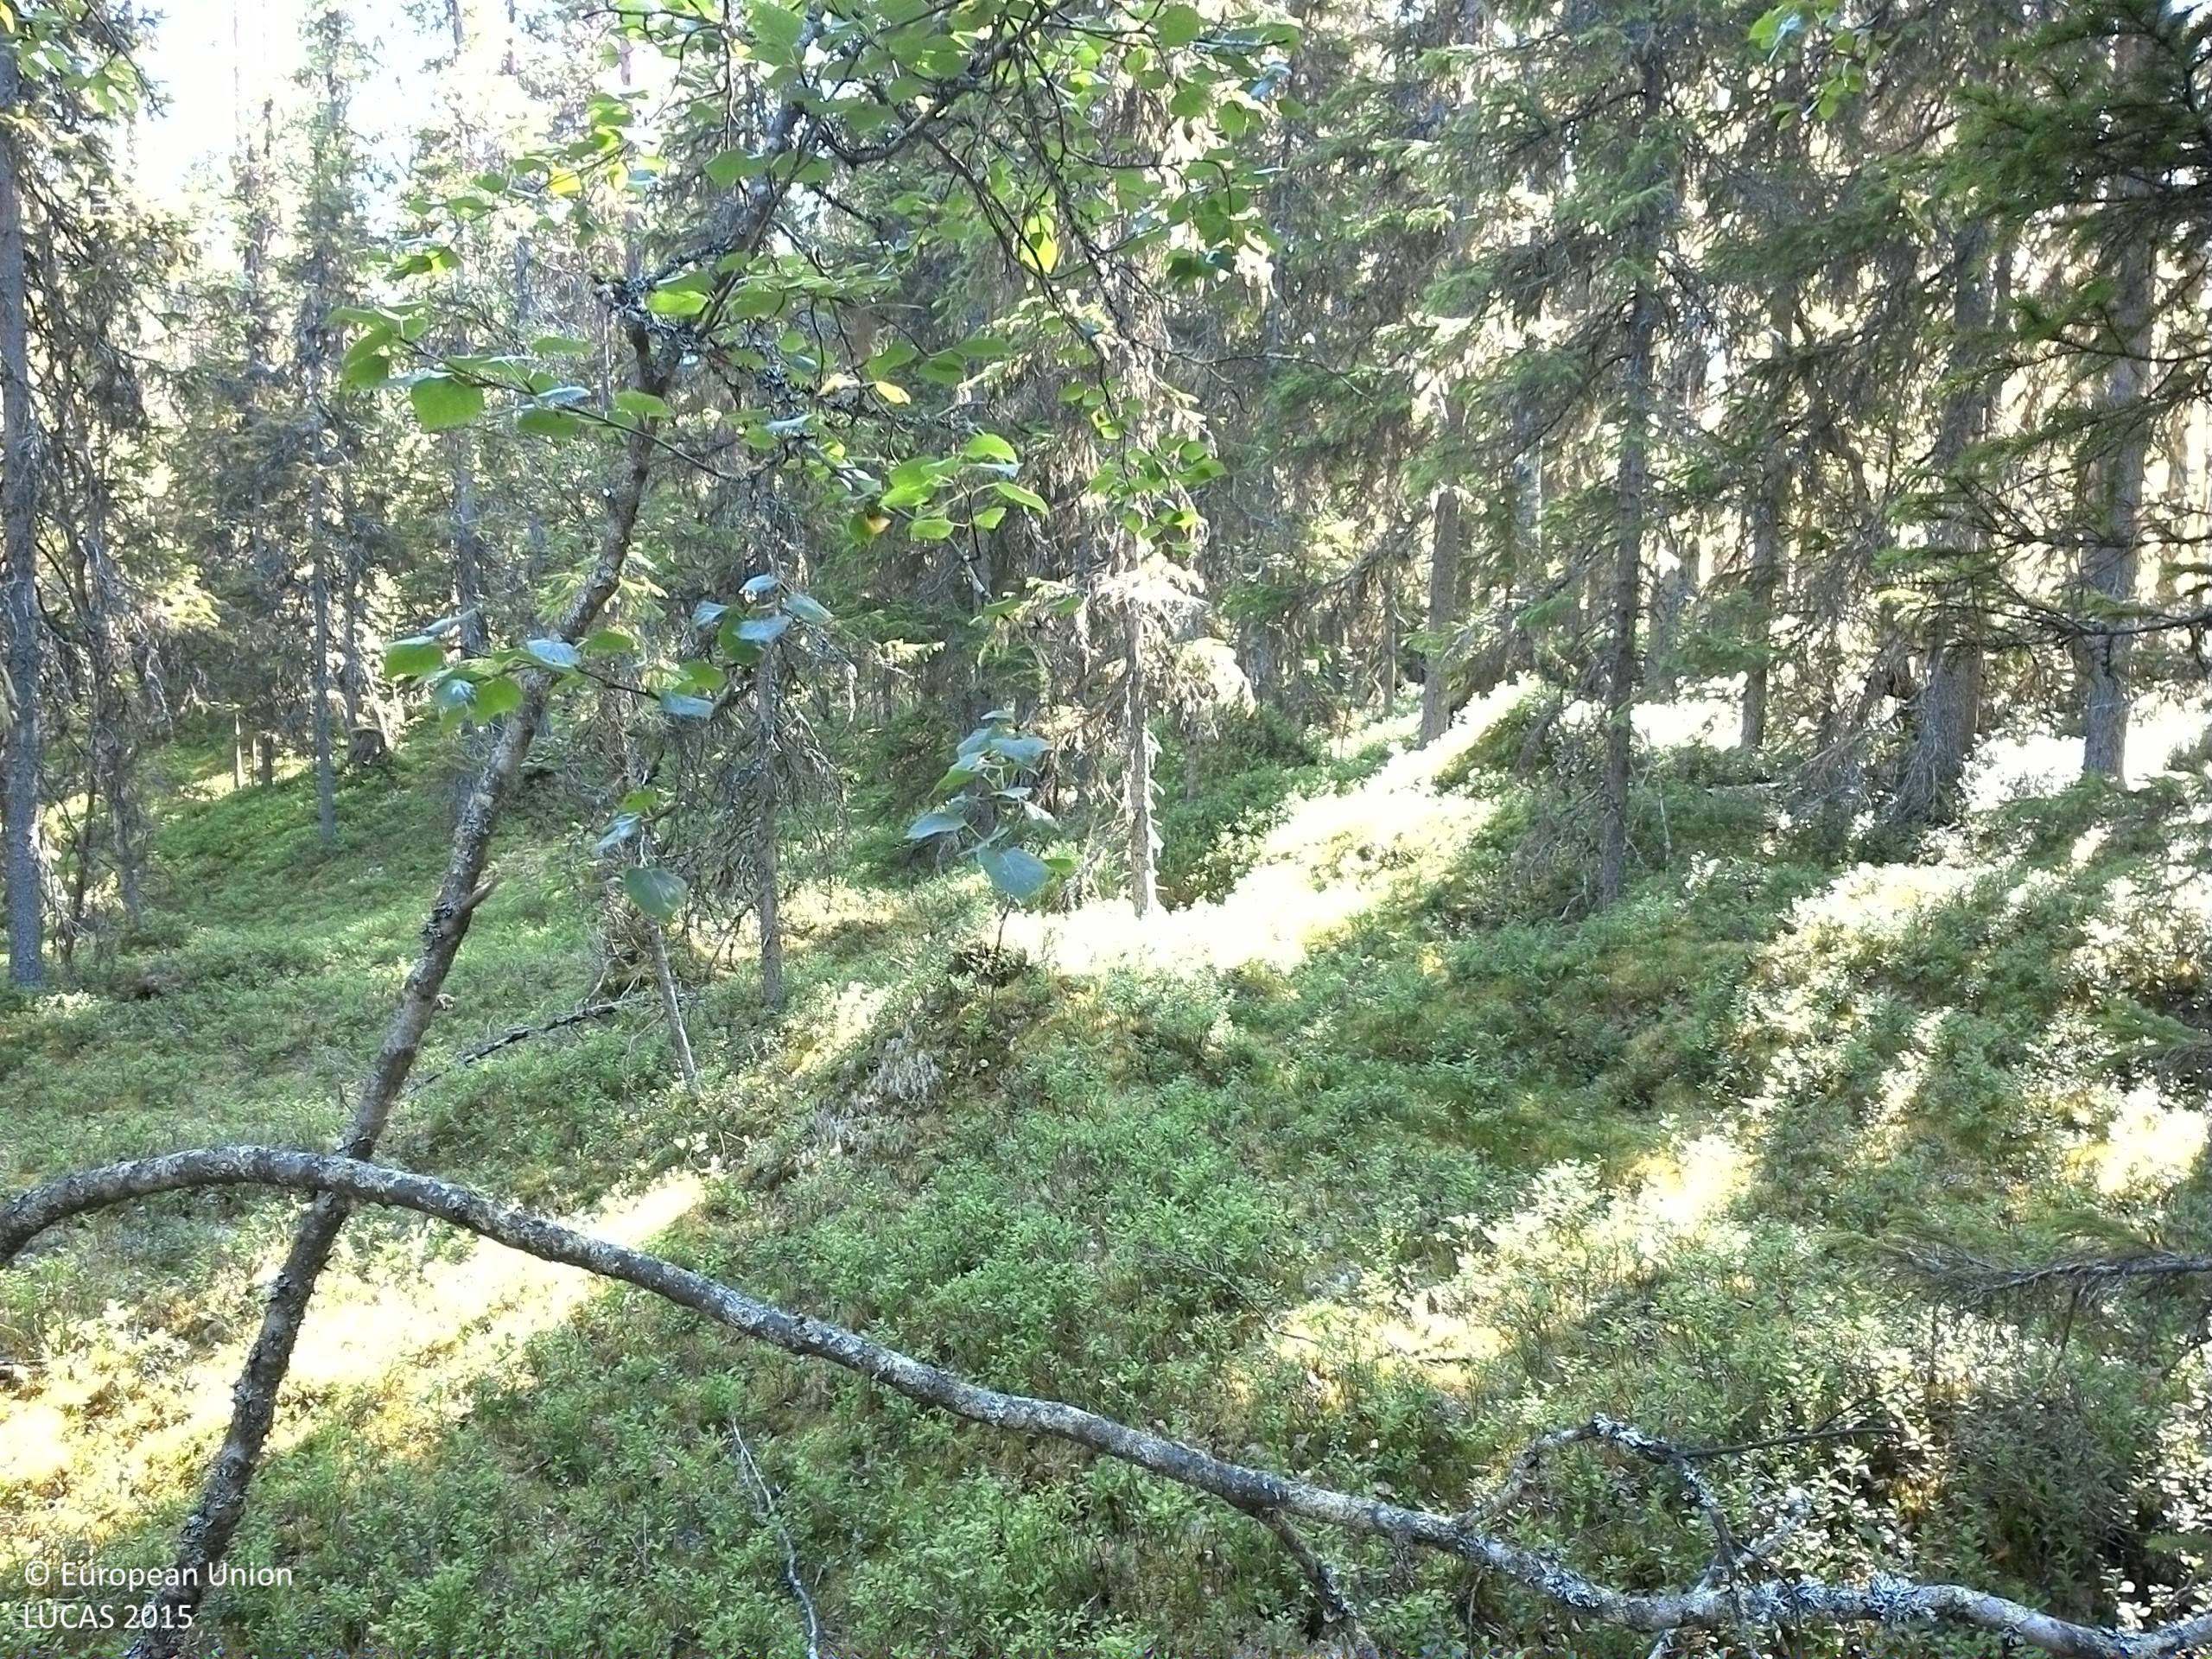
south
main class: Woodland
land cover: Spruce dominated coniferous woodland
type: boreal forest
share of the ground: 50 - 75 %
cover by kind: coniferous forest trees 55 %, shrubs 25 %, broadleaved forest trees 10 %, herbaceous plants 10 %
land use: Forestry
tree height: > 5 m
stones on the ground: < 10 %
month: August
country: SE
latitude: 63.9636
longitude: 16.7705
